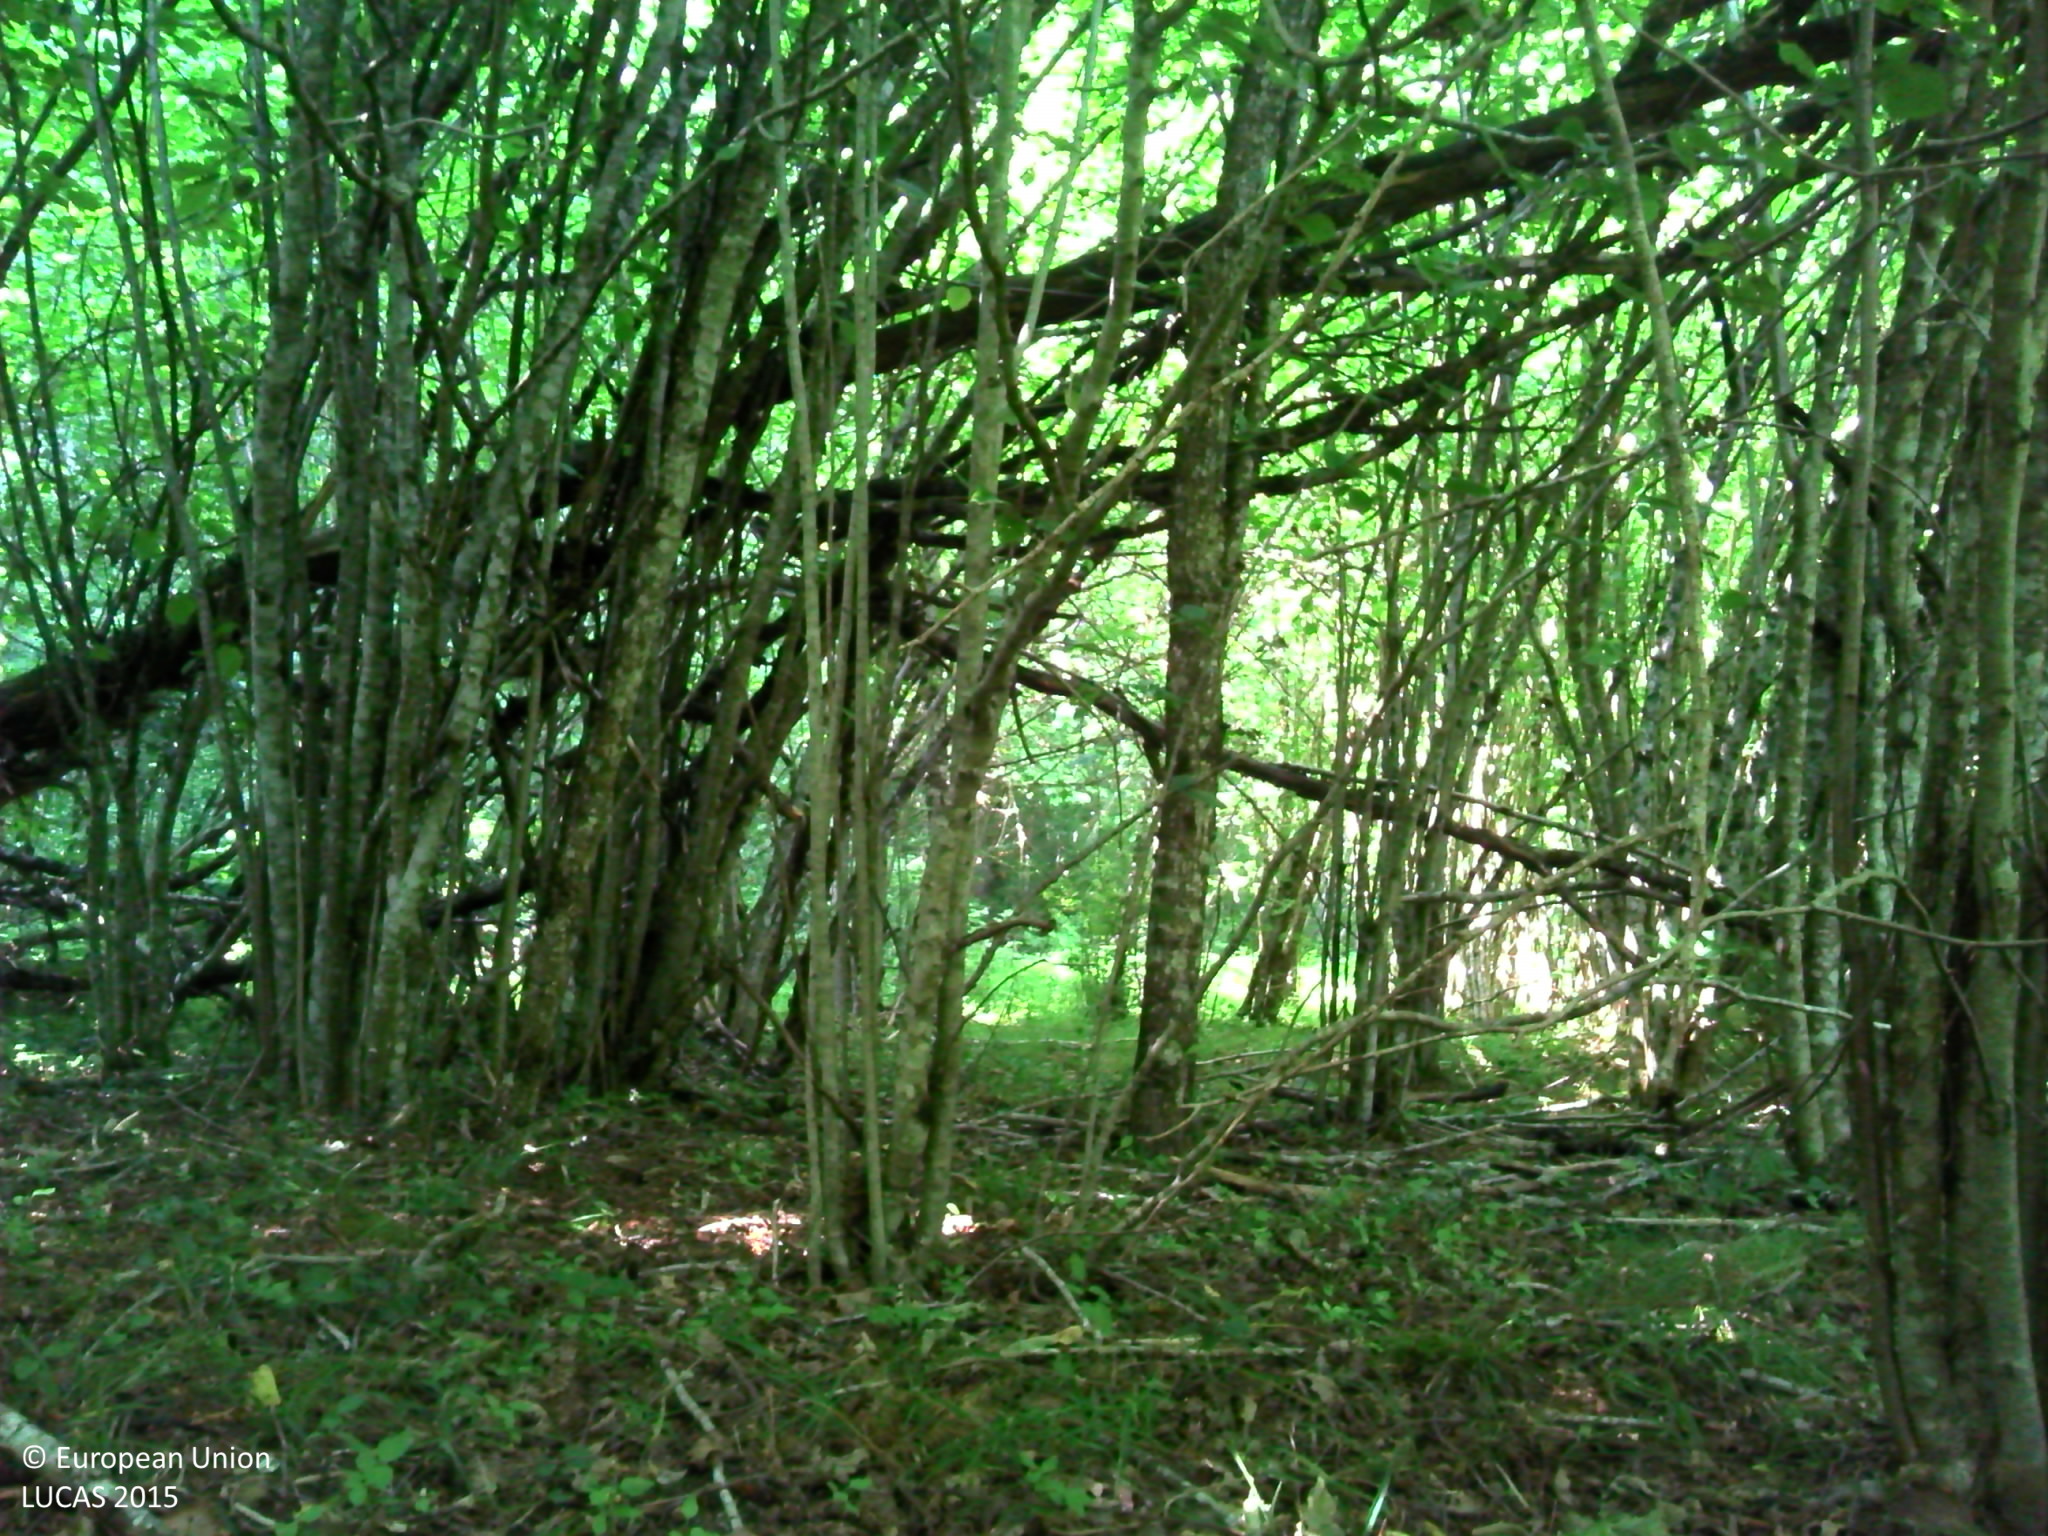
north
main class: Woodland
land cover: Broadleaved woodland
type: mesophytic deciduous forest
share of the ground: > 75 %
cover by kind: broadleaved forest trees 100 %
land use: Forestry
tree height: > 5 m
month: July
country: FR
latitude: 43.6321
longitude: 2.5823
